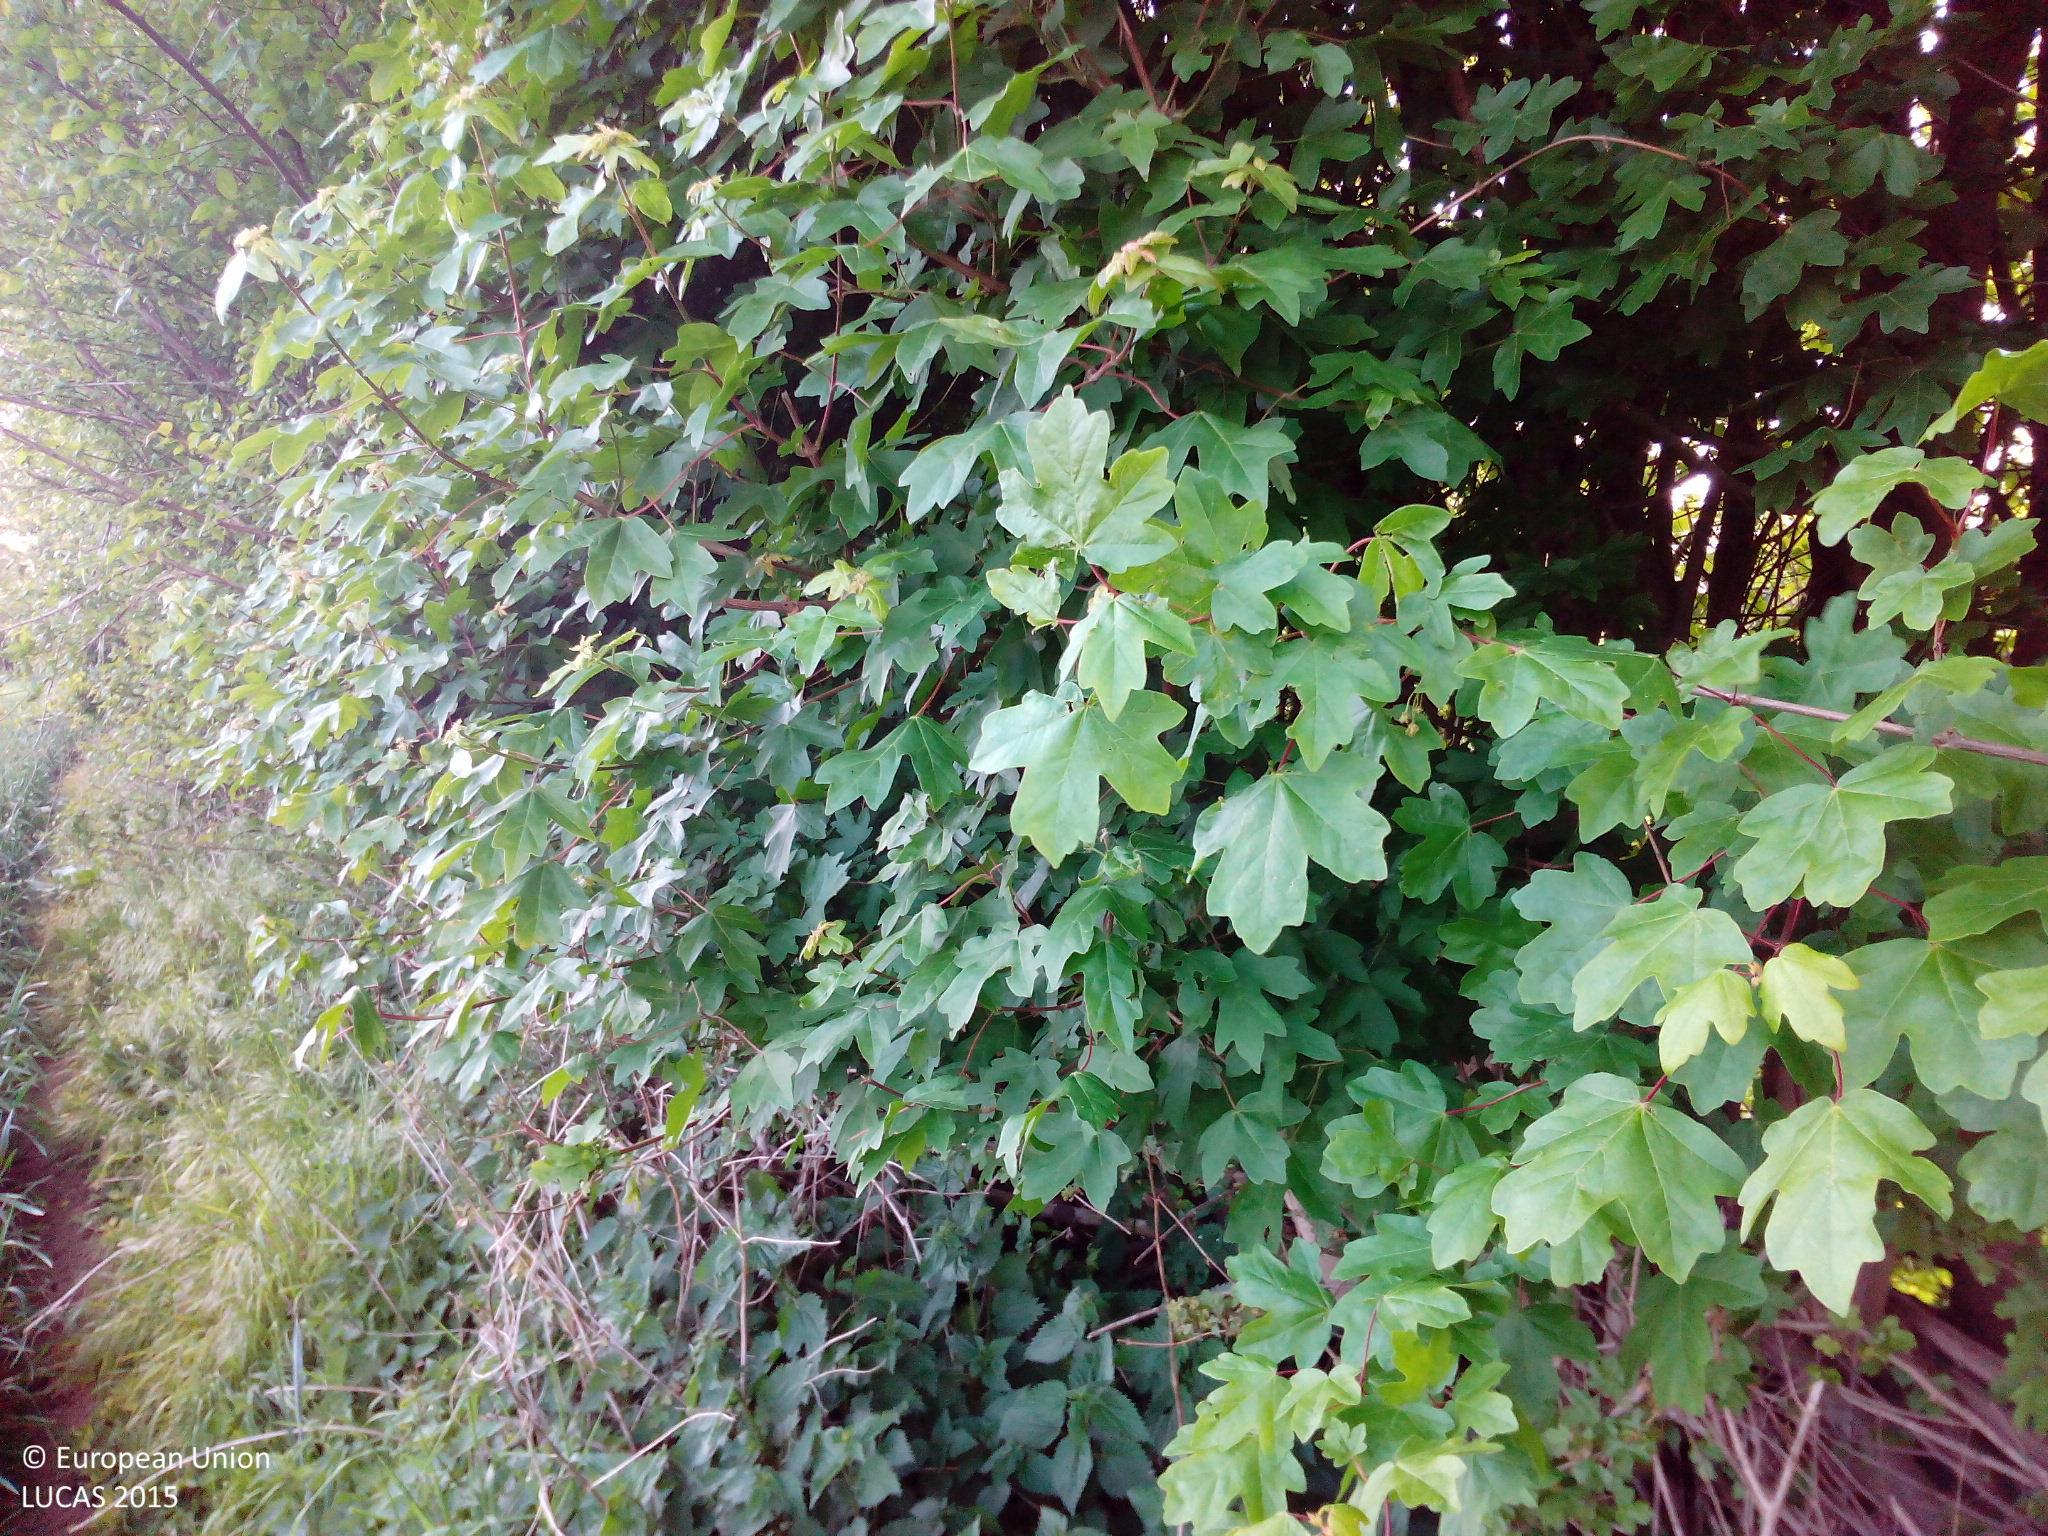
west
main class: Cropland
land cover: Common wheat
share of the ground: > 75 %
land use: Agriculture (excluding fallow land and kitchen gardens)
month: May
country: DE
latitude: 51.8564
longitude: 7.9532
